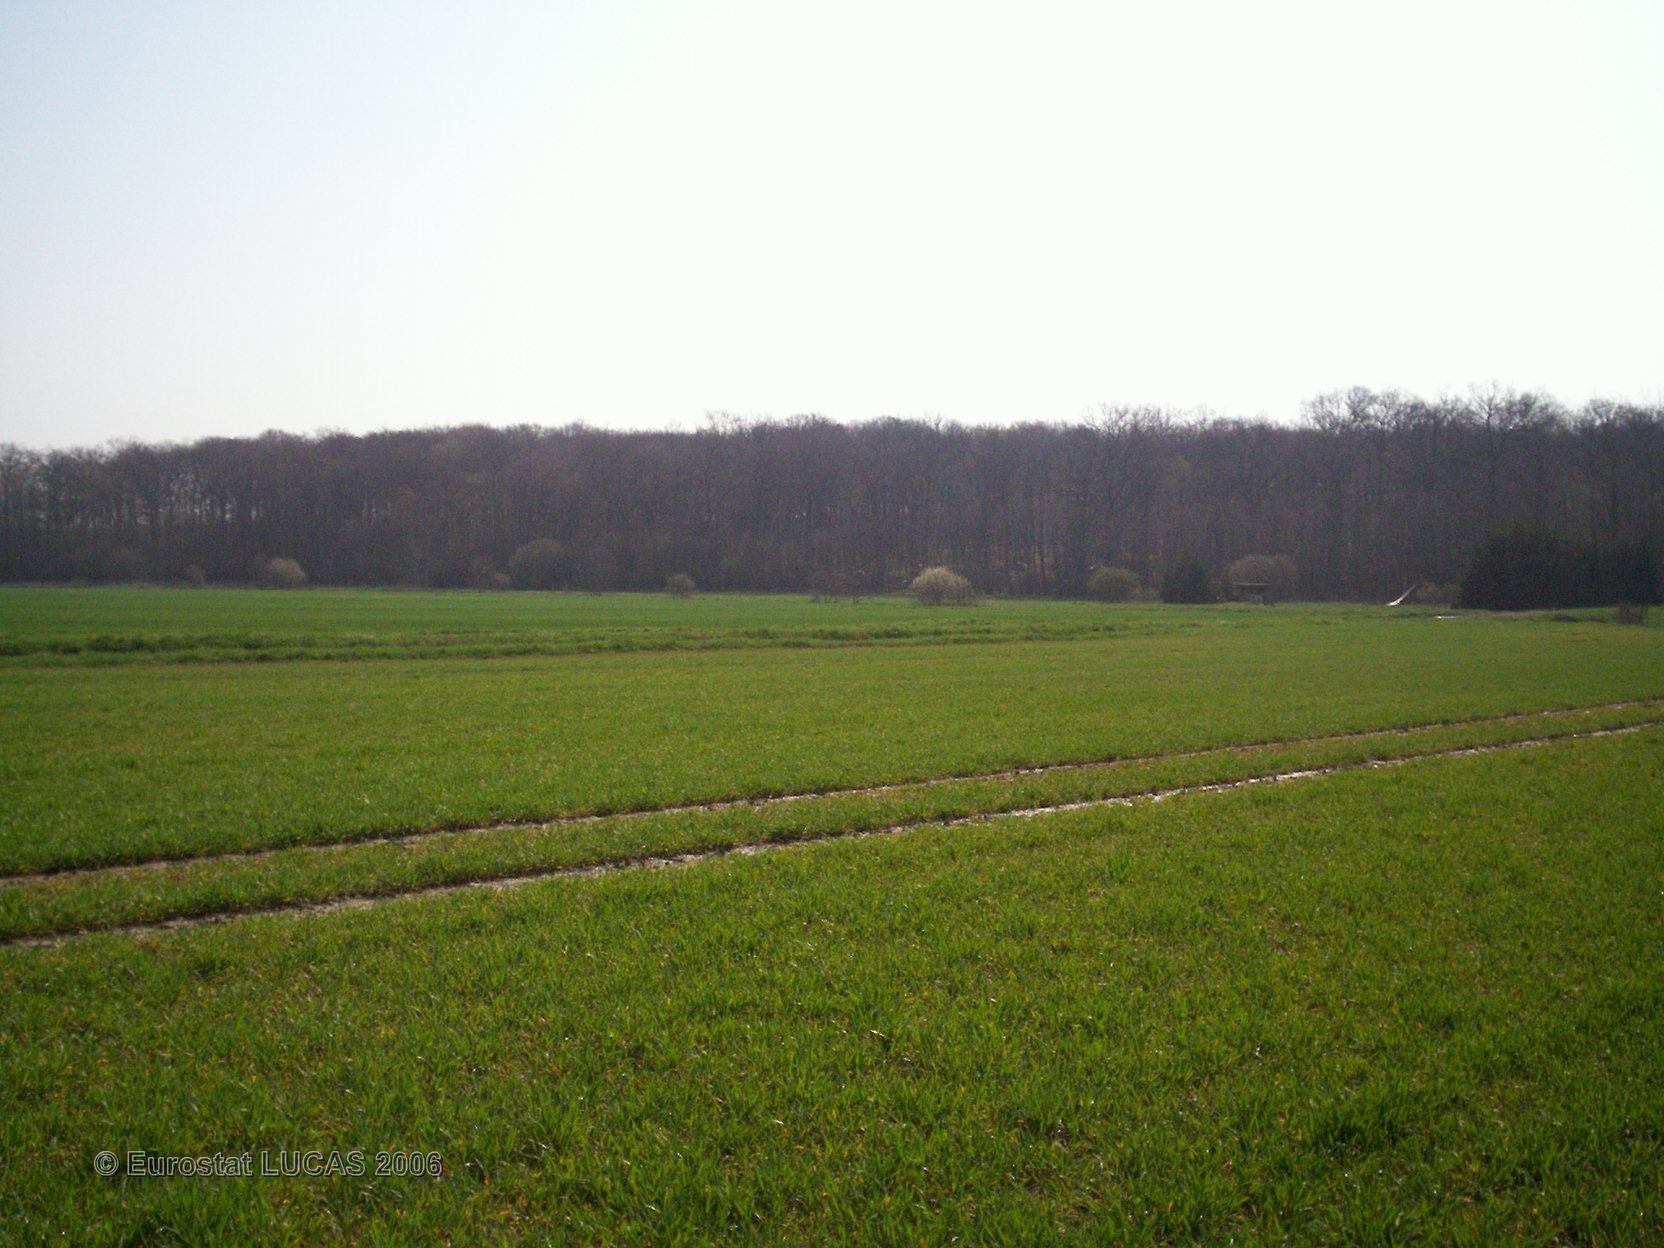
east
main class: Cropland
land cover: Common wheat
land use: Agriculture (excluding fallow land and kitchen gardens)
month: April
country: FR
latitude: 48.2234
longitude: 6.5414
